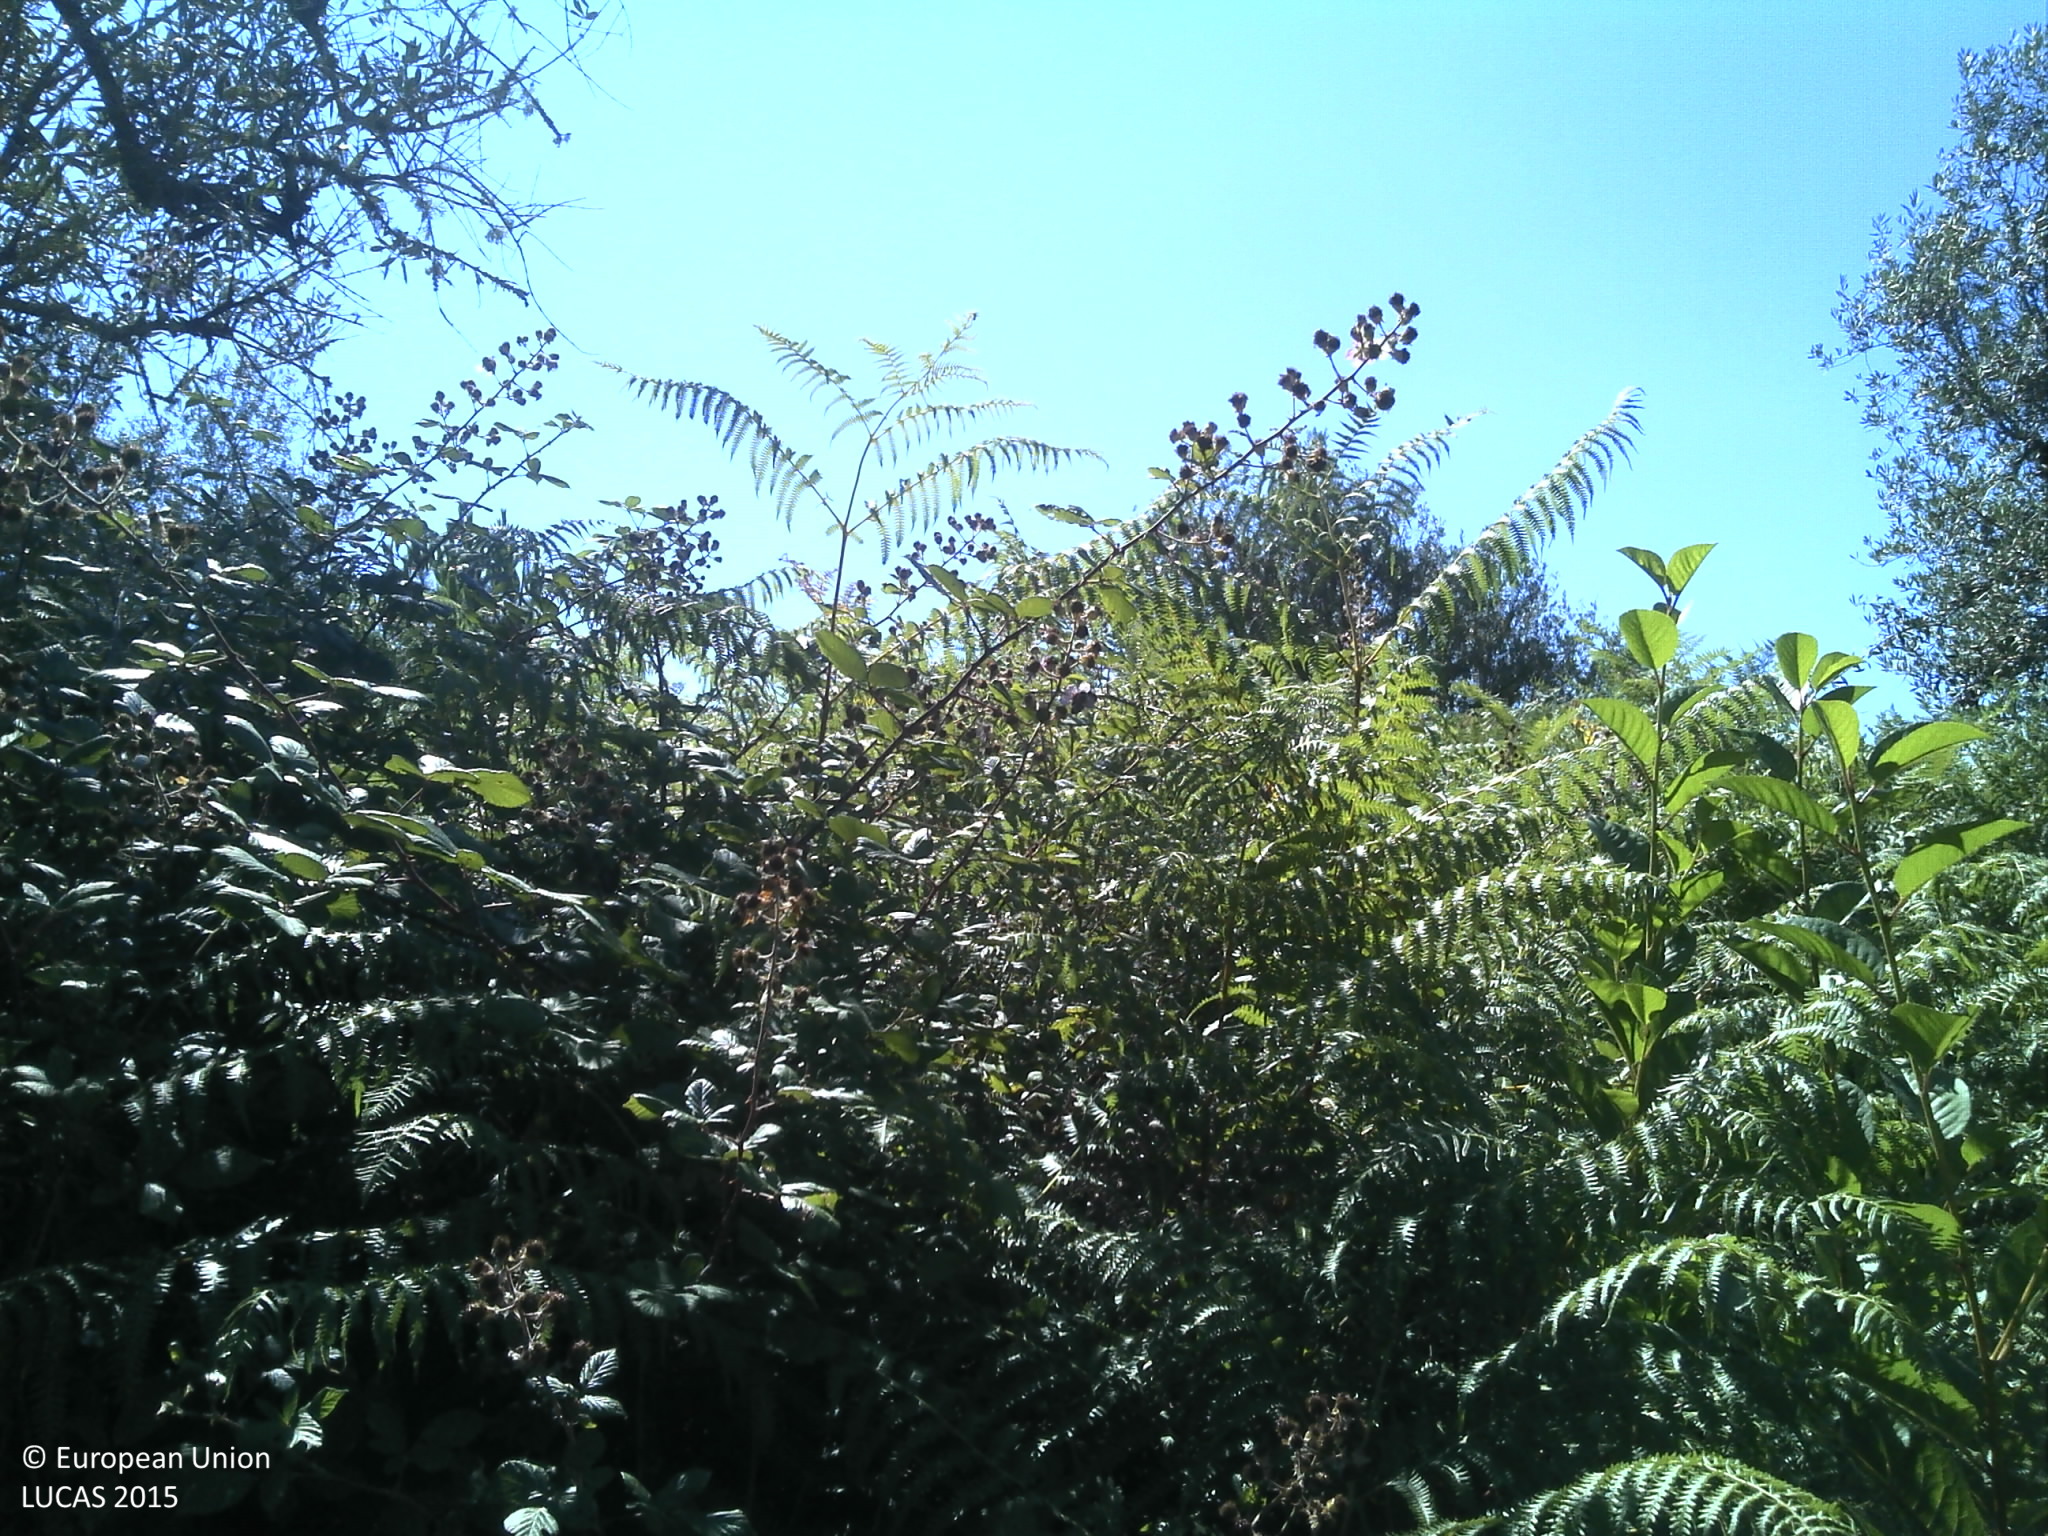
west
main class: Shrubland
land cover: Shrubland with sparse tree cover
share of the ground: > 75 %
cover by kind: shrubs 80 %, consolidated bare surface 10 %, broadleaved forest trees 5 %, unconsolidated bare surface 5 %
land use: Abandoned areas
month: July
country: PT
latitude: 40.2802
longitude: -7.9371
